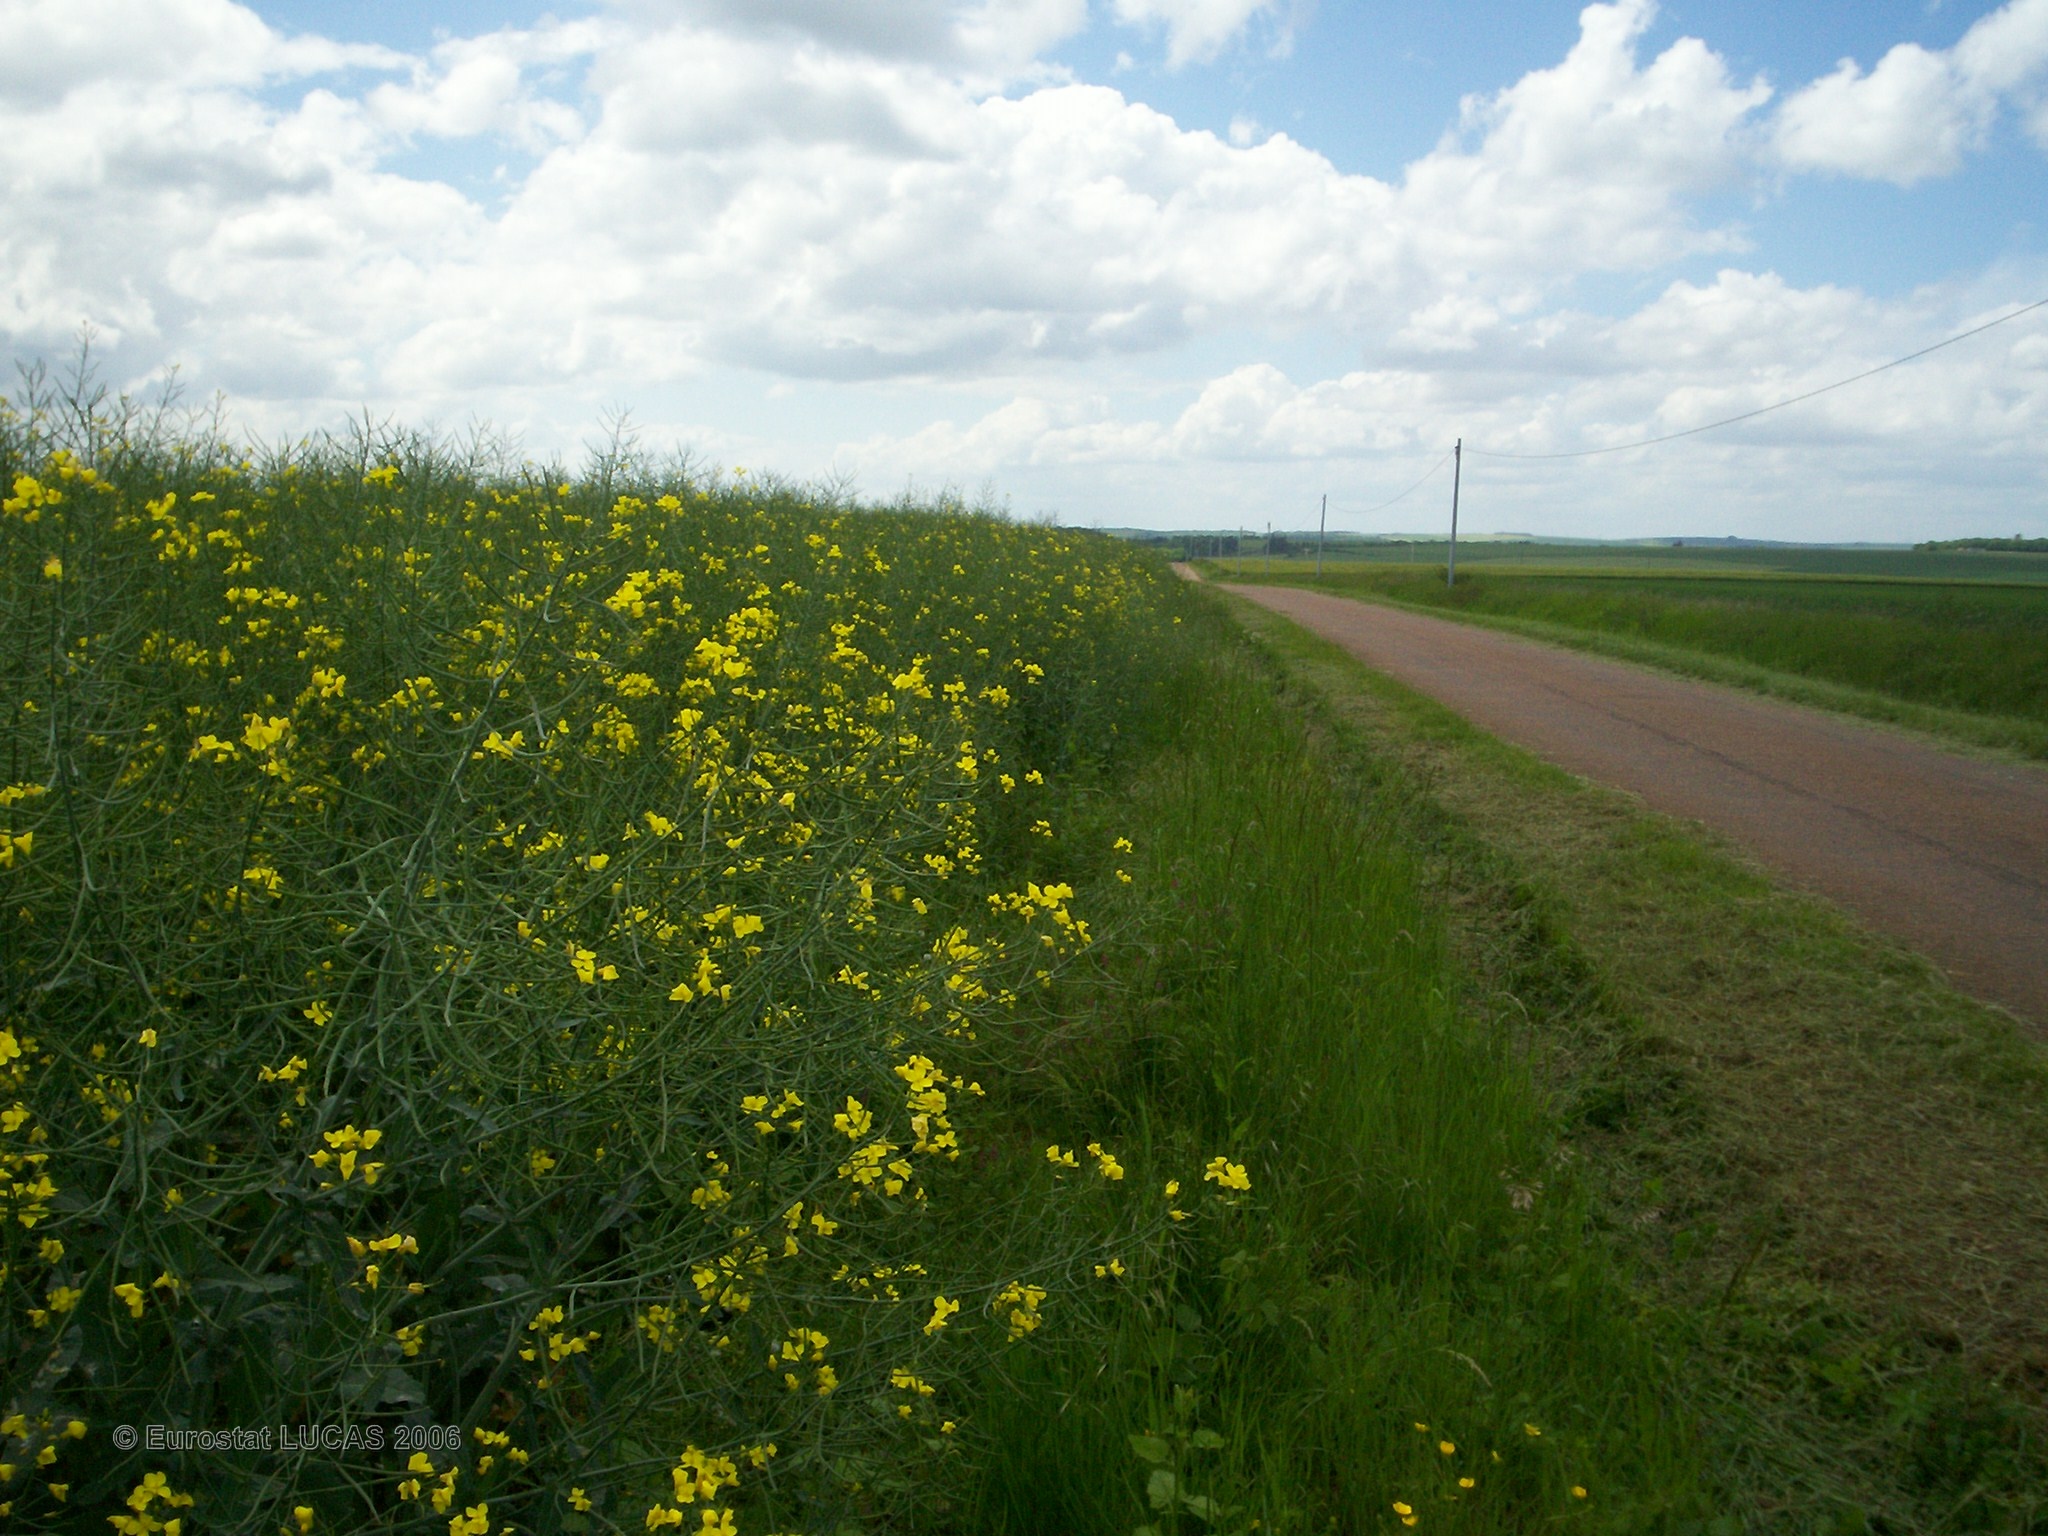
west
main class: Cropland
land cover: Rape and turnip rape
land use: Agriculture (excluding fallow land and kitchen gardens)
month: May
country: FR
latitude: 47.7567
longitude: 4.0610
